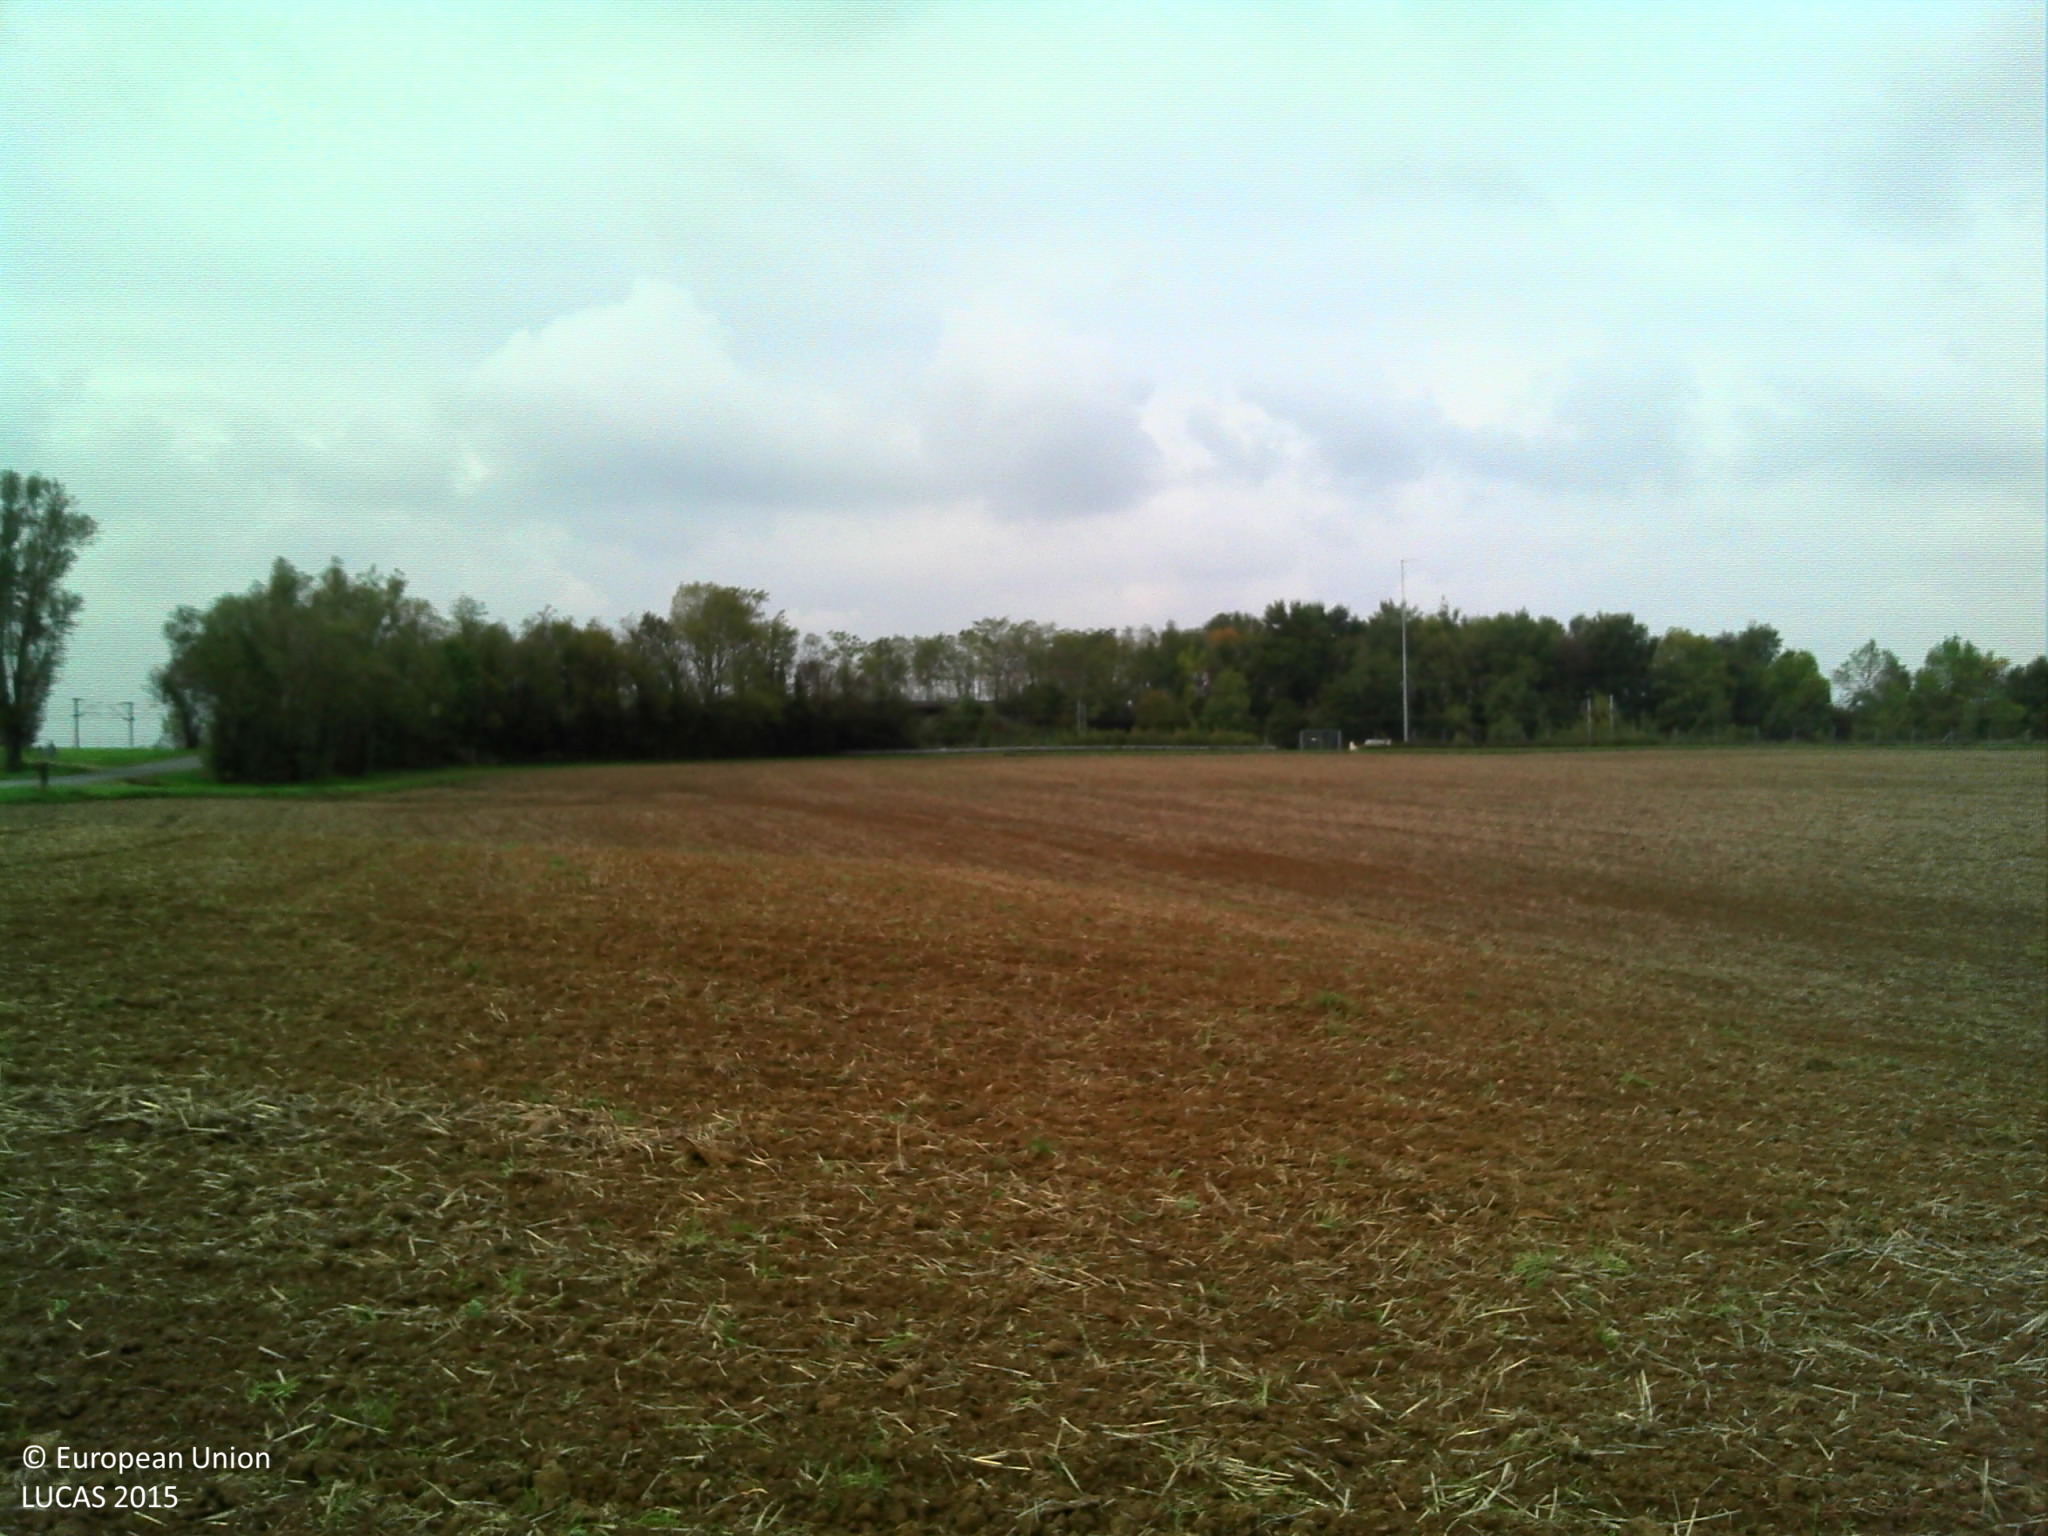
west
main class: Cropland
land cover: Common wheat
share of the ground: < 10 %
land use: Agriculture (excluding fallow land and kitchen gardens)
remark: Harvested field
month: October
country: FR
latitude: 46.1915
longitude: 4.8586
